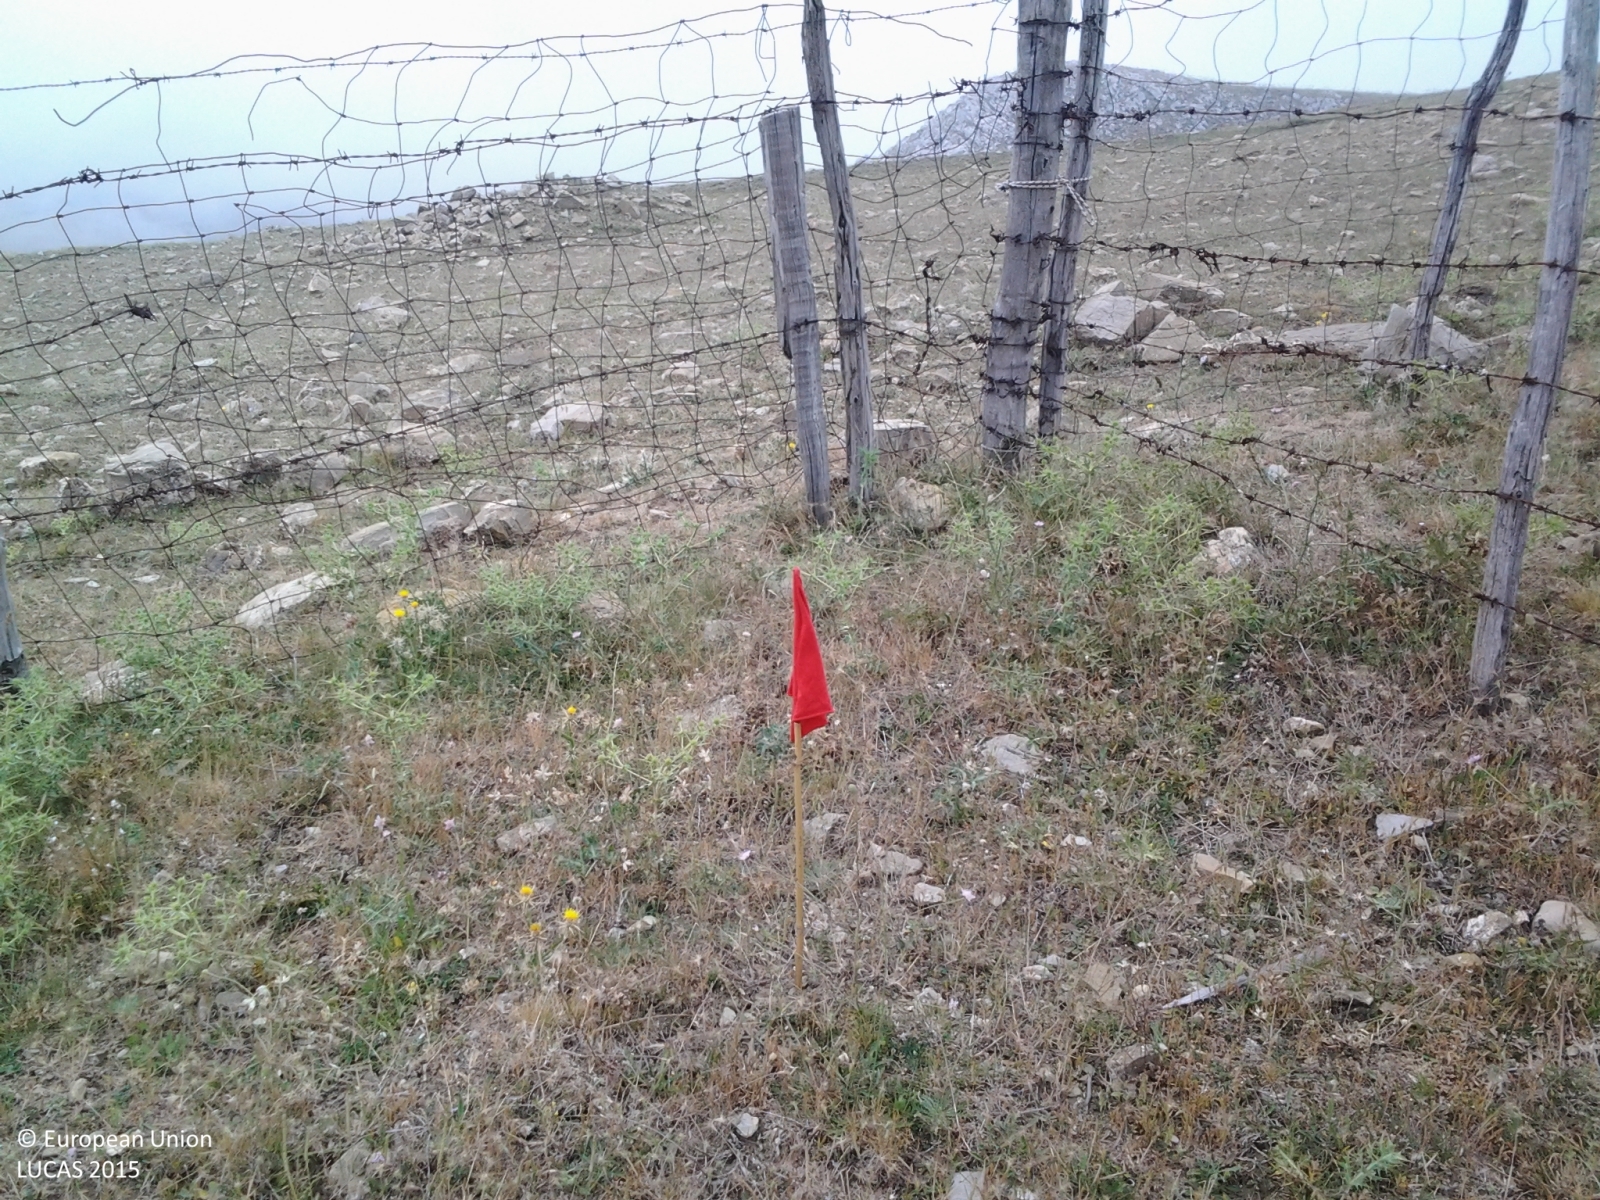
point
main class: Grassland
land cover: Spontaneously vegetated surfaces
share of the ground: > 75 %
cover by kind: herbaceous plants 90 %, shrubs 5 %, unconsolidated bare surface 5 %
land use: Agriculture (excluding fallow land and kitchen gardens)
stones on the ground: > 50 %
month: July
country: IT
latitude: 37.9691
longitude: 14.8507
